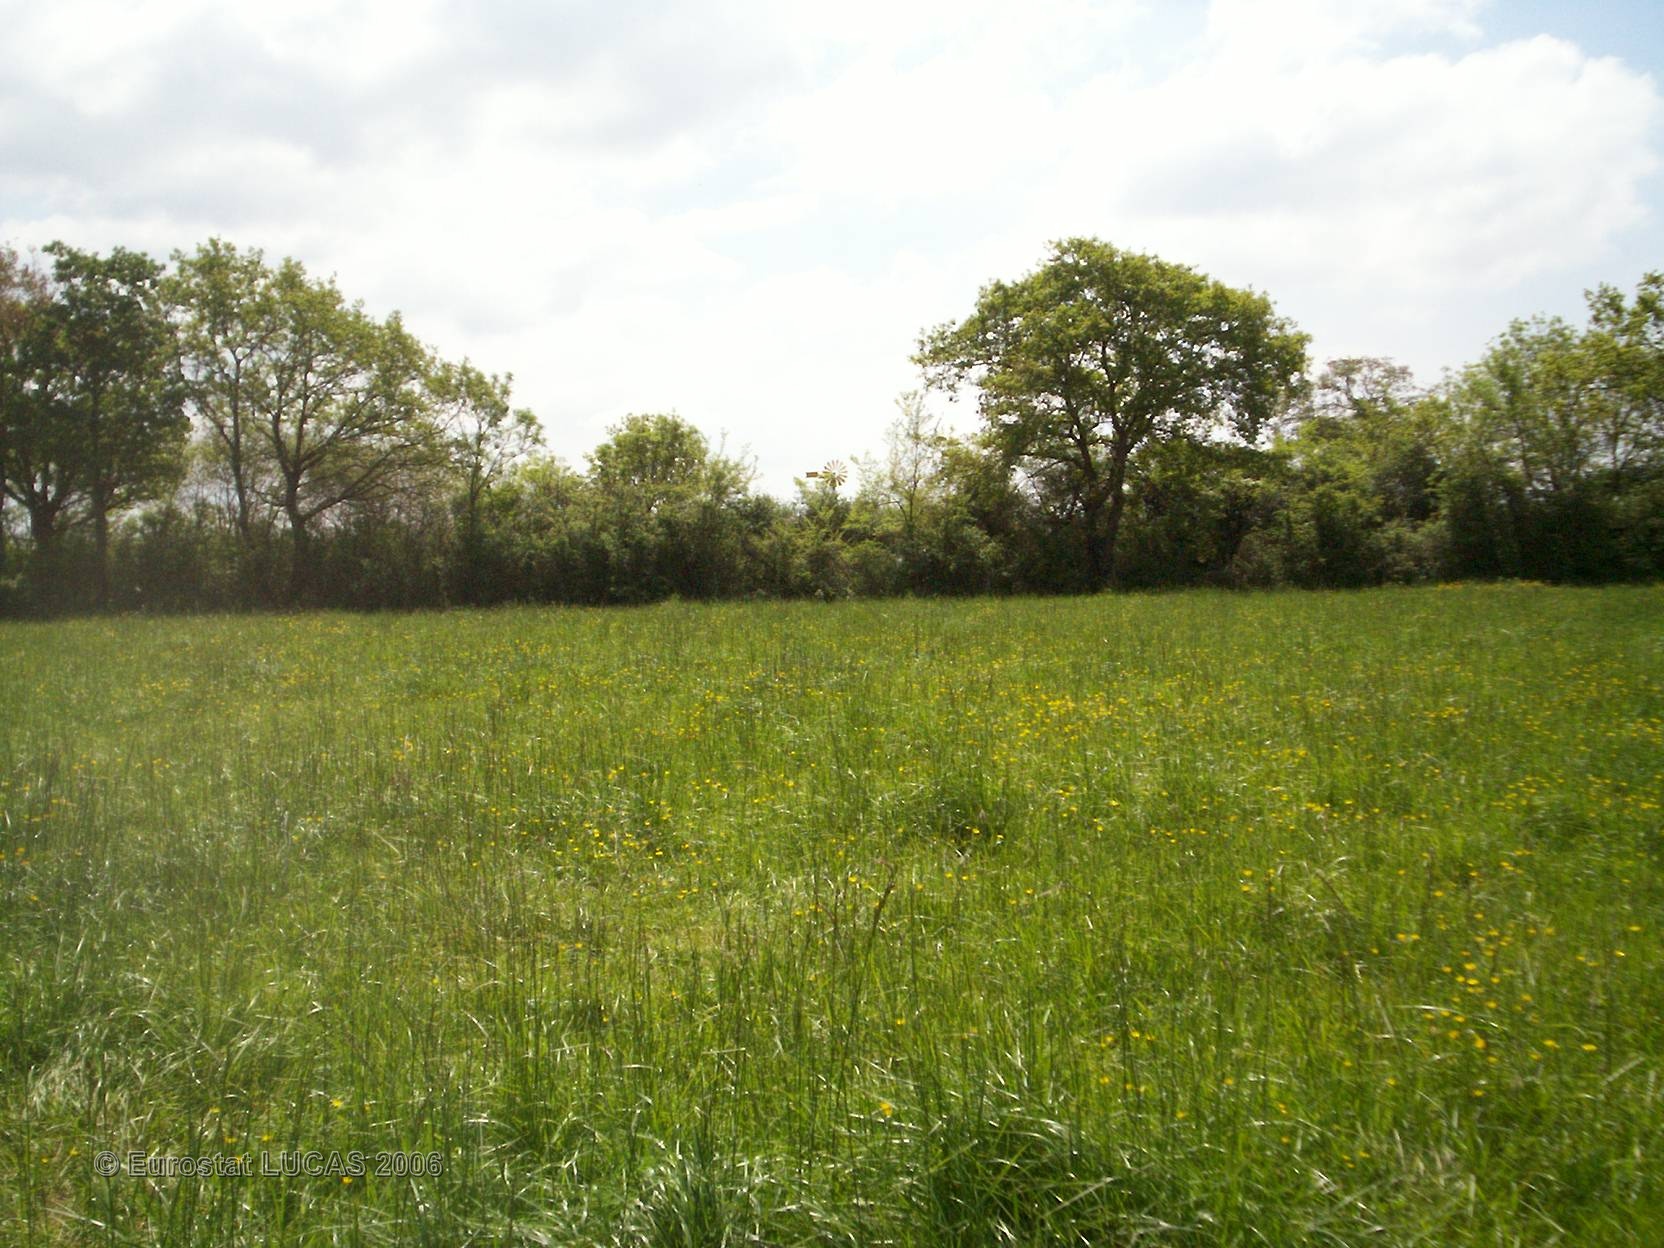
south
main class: Grassland
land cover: Grassland without tree/shrub cover
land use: Agriculture (excluding fallow land and kitchen gardens)
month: May
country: FR
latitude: 47.2436
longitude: -2.1117
